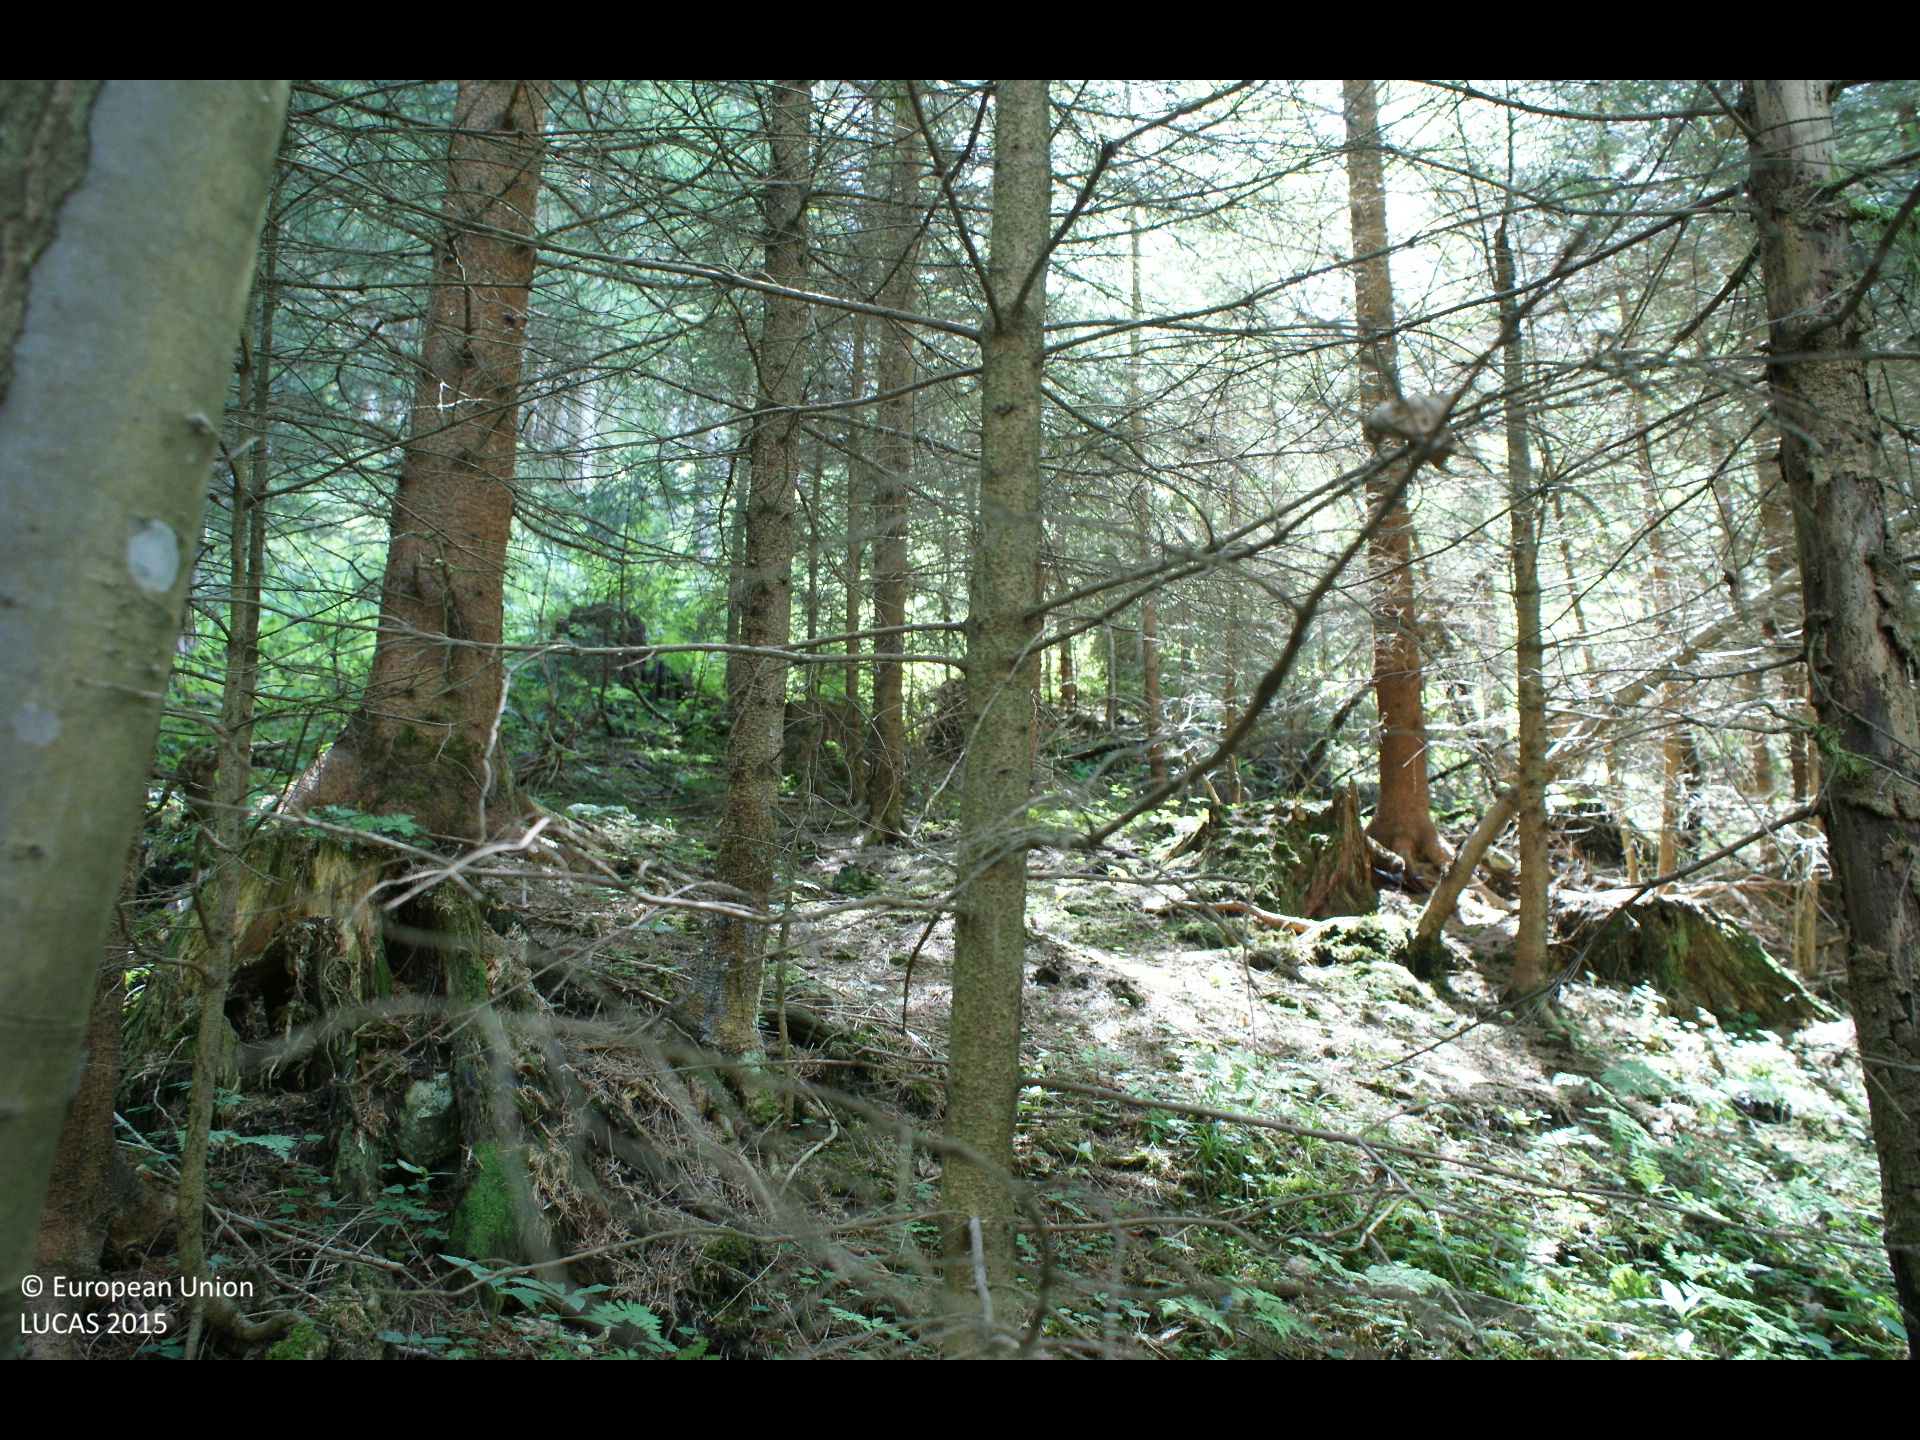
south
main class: Woodland
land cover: Spruce dominated mixed woodland
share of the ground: > 75 %
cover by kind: coniferous forest trees 65 %, broadleaved forest trees 25 %, herbaceous plants 5 %, lichens and mosses 5 %
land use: Forestry
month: July
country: AT
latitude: 47.7937
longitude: 14.8194
